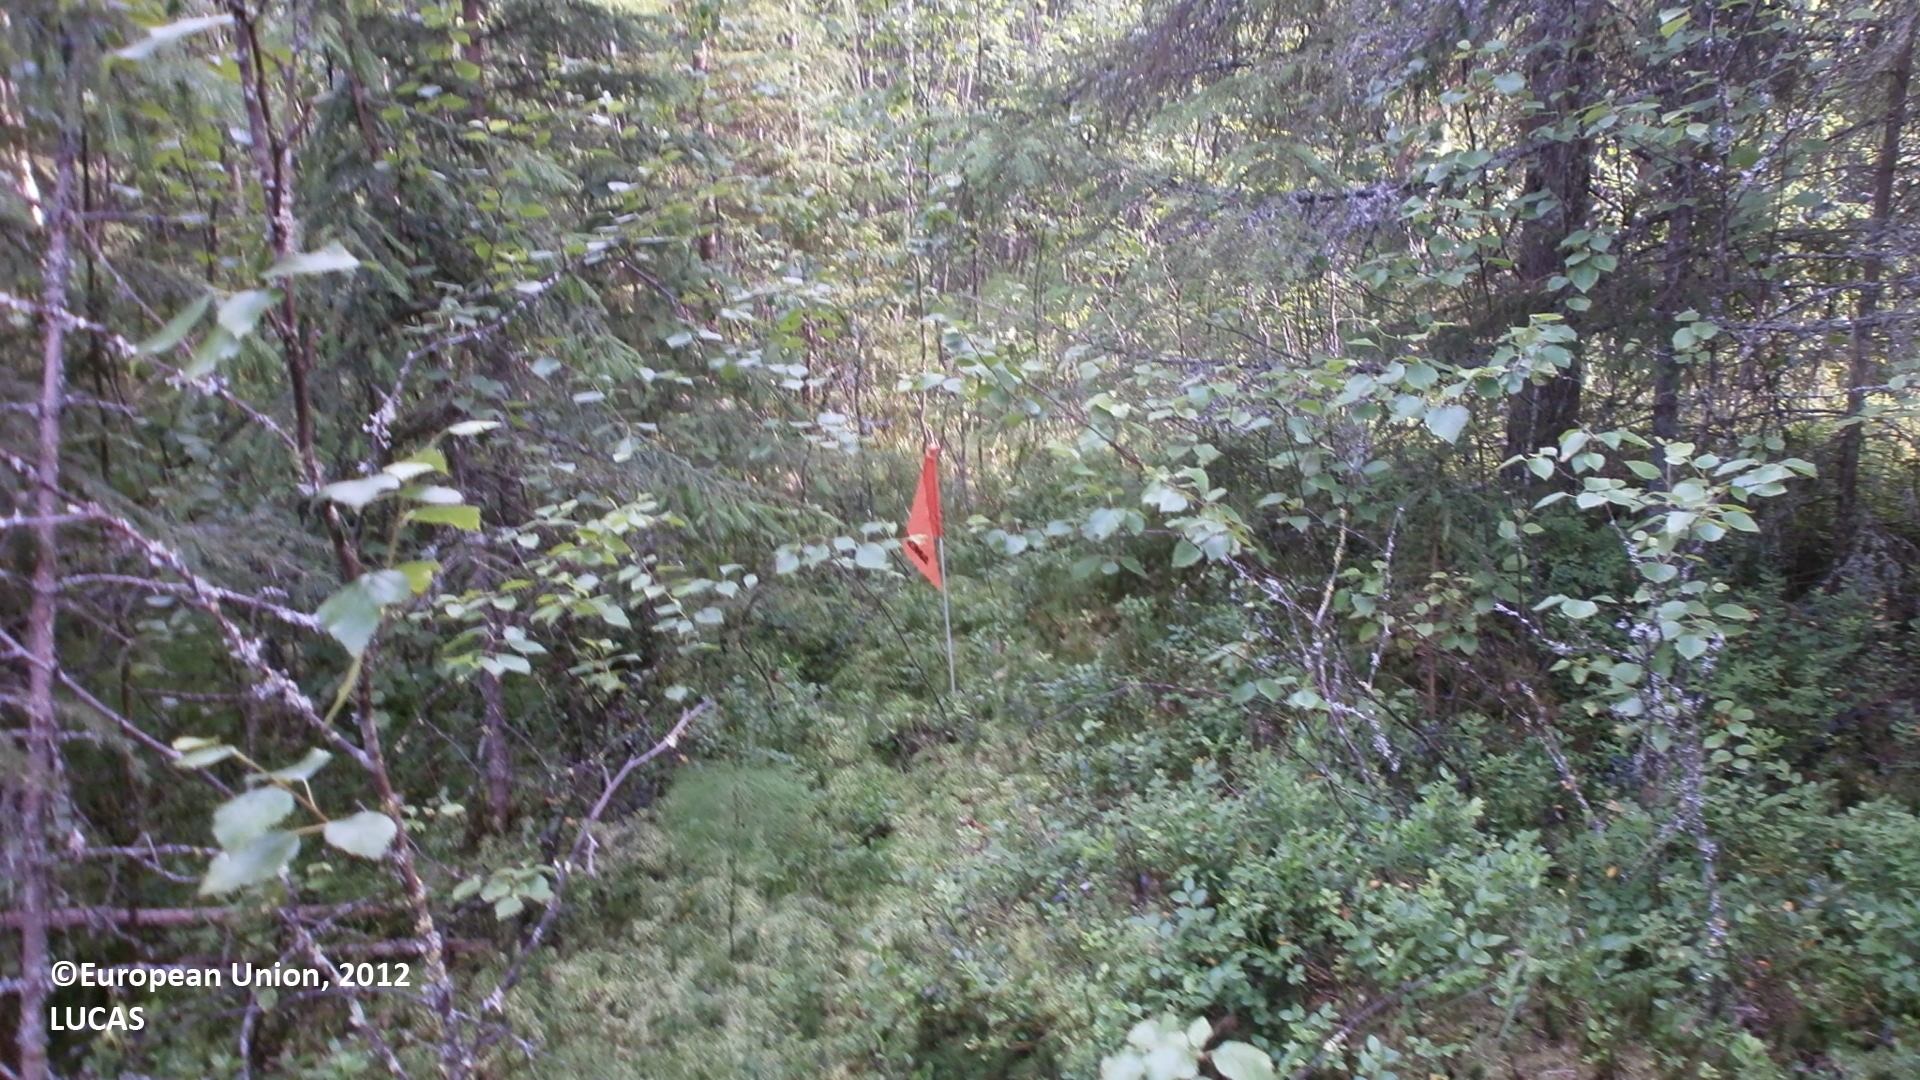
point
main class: Woodland
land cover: Spruce dominated mixed woodland
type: boreal forest
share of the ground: 50 - 75 %
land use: Forestry
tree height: > 5 m
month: July
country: FI
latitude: 64.3369
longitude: 24.2846
